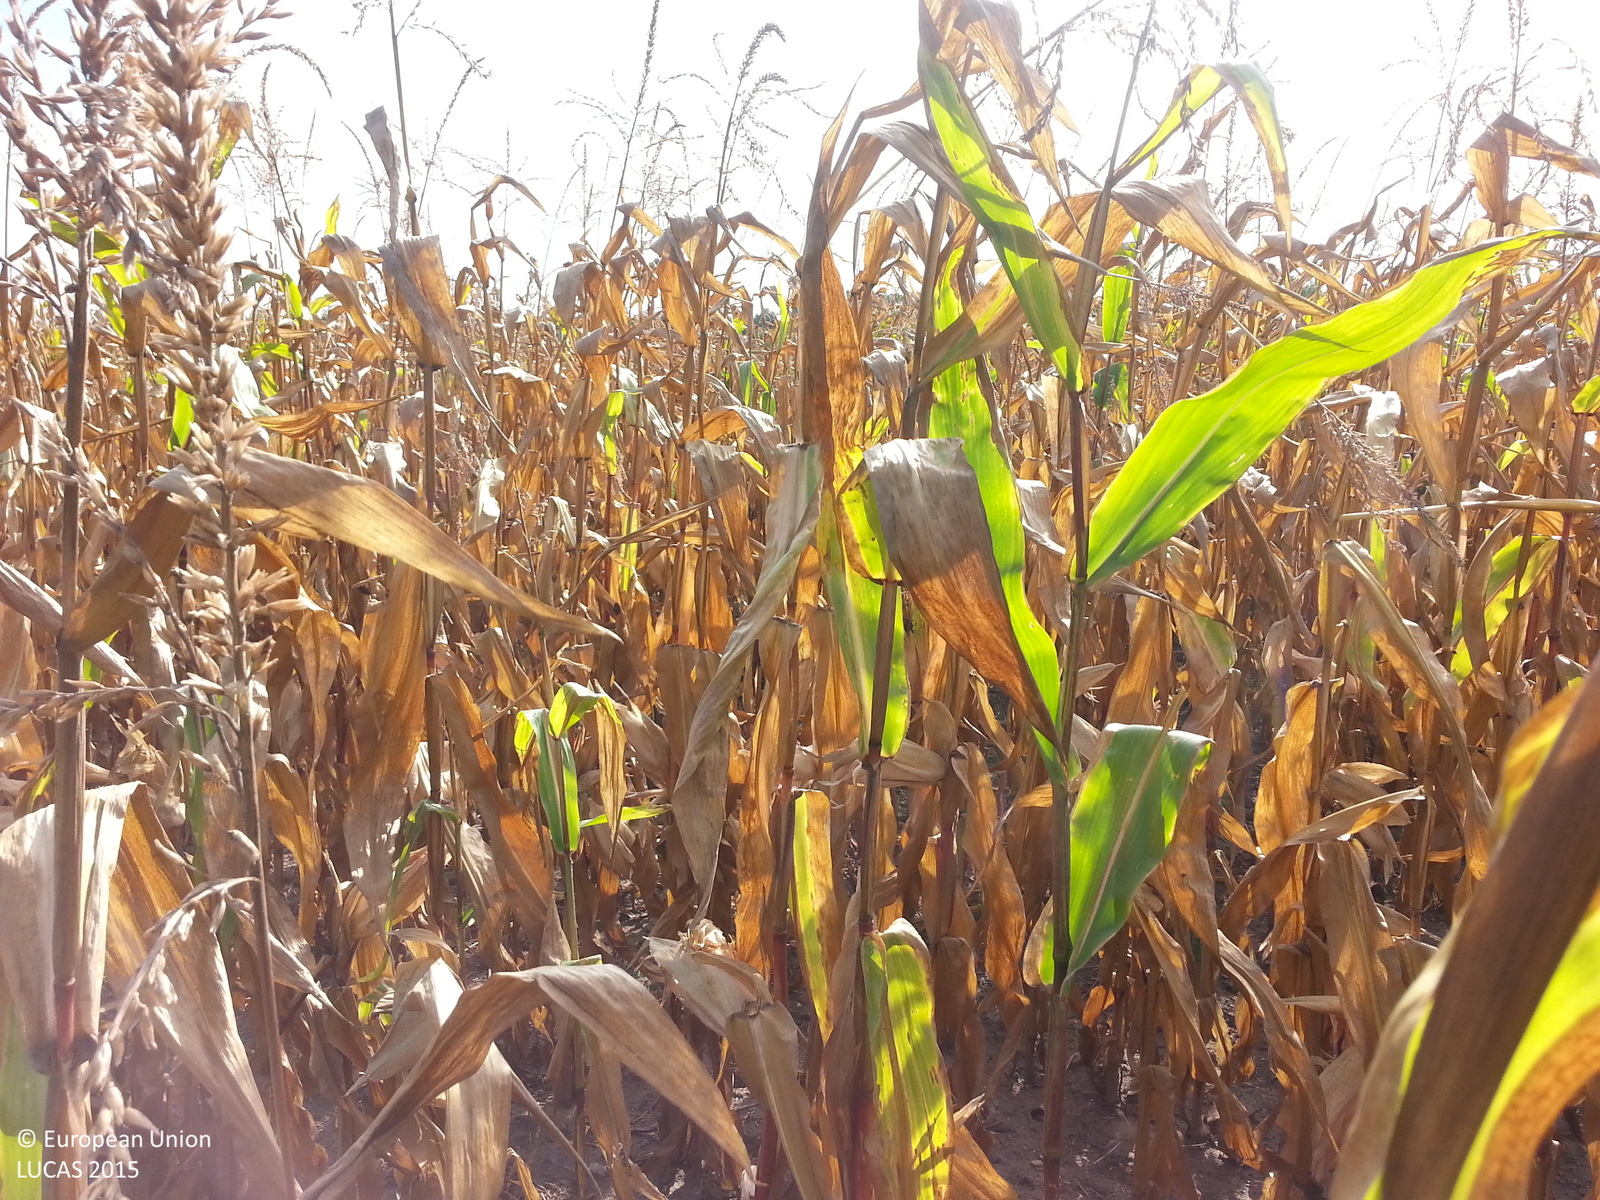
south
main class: Cropland
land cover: Maize
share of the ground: > 75 %
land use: Agriculture (excluding fallow land and kitchen gardens)
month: September
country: PL
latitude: 53.4137
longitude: 18.1855
